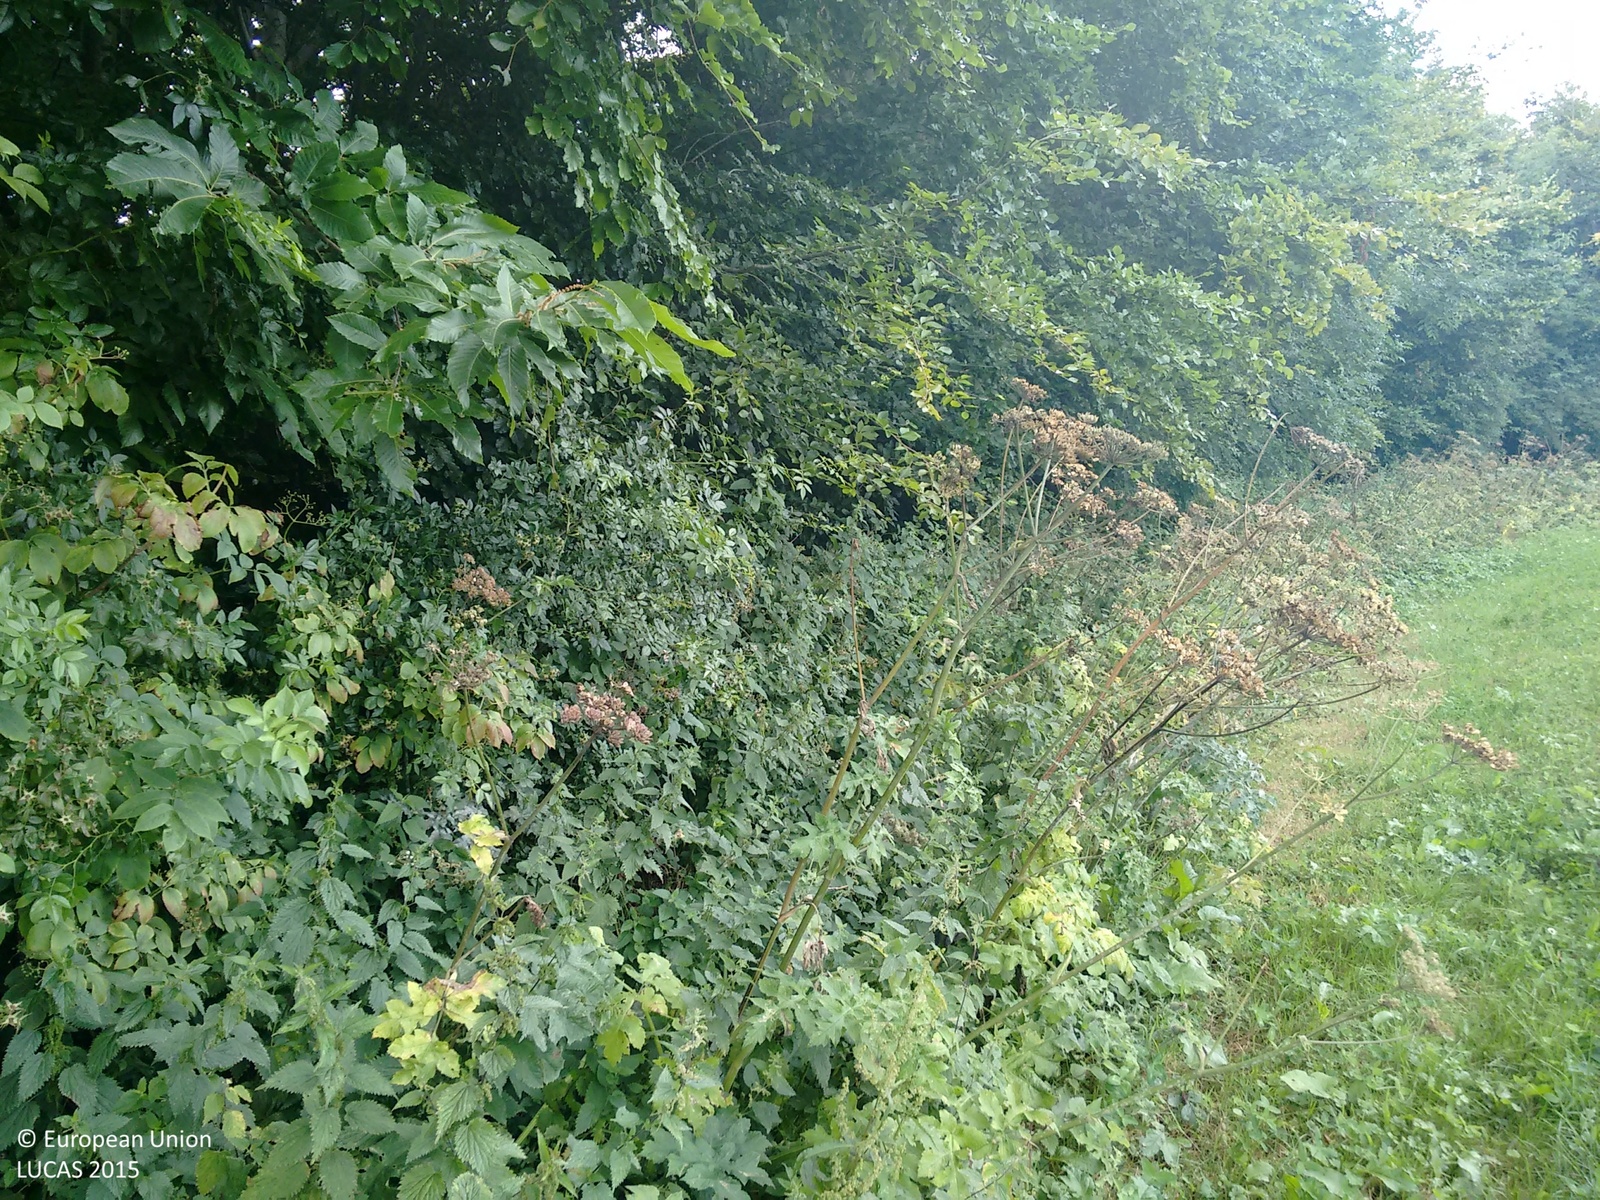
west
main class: Woodland
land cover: Broadleaved woodland
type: mesophytic deciduous forest
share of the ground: > 75 %
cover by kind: broadleaved forest trees 100 %
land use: Semi-natural and natural areas not in use
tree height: > 5 m
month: July
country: GB
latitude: 50.6930
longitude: -3.3165
